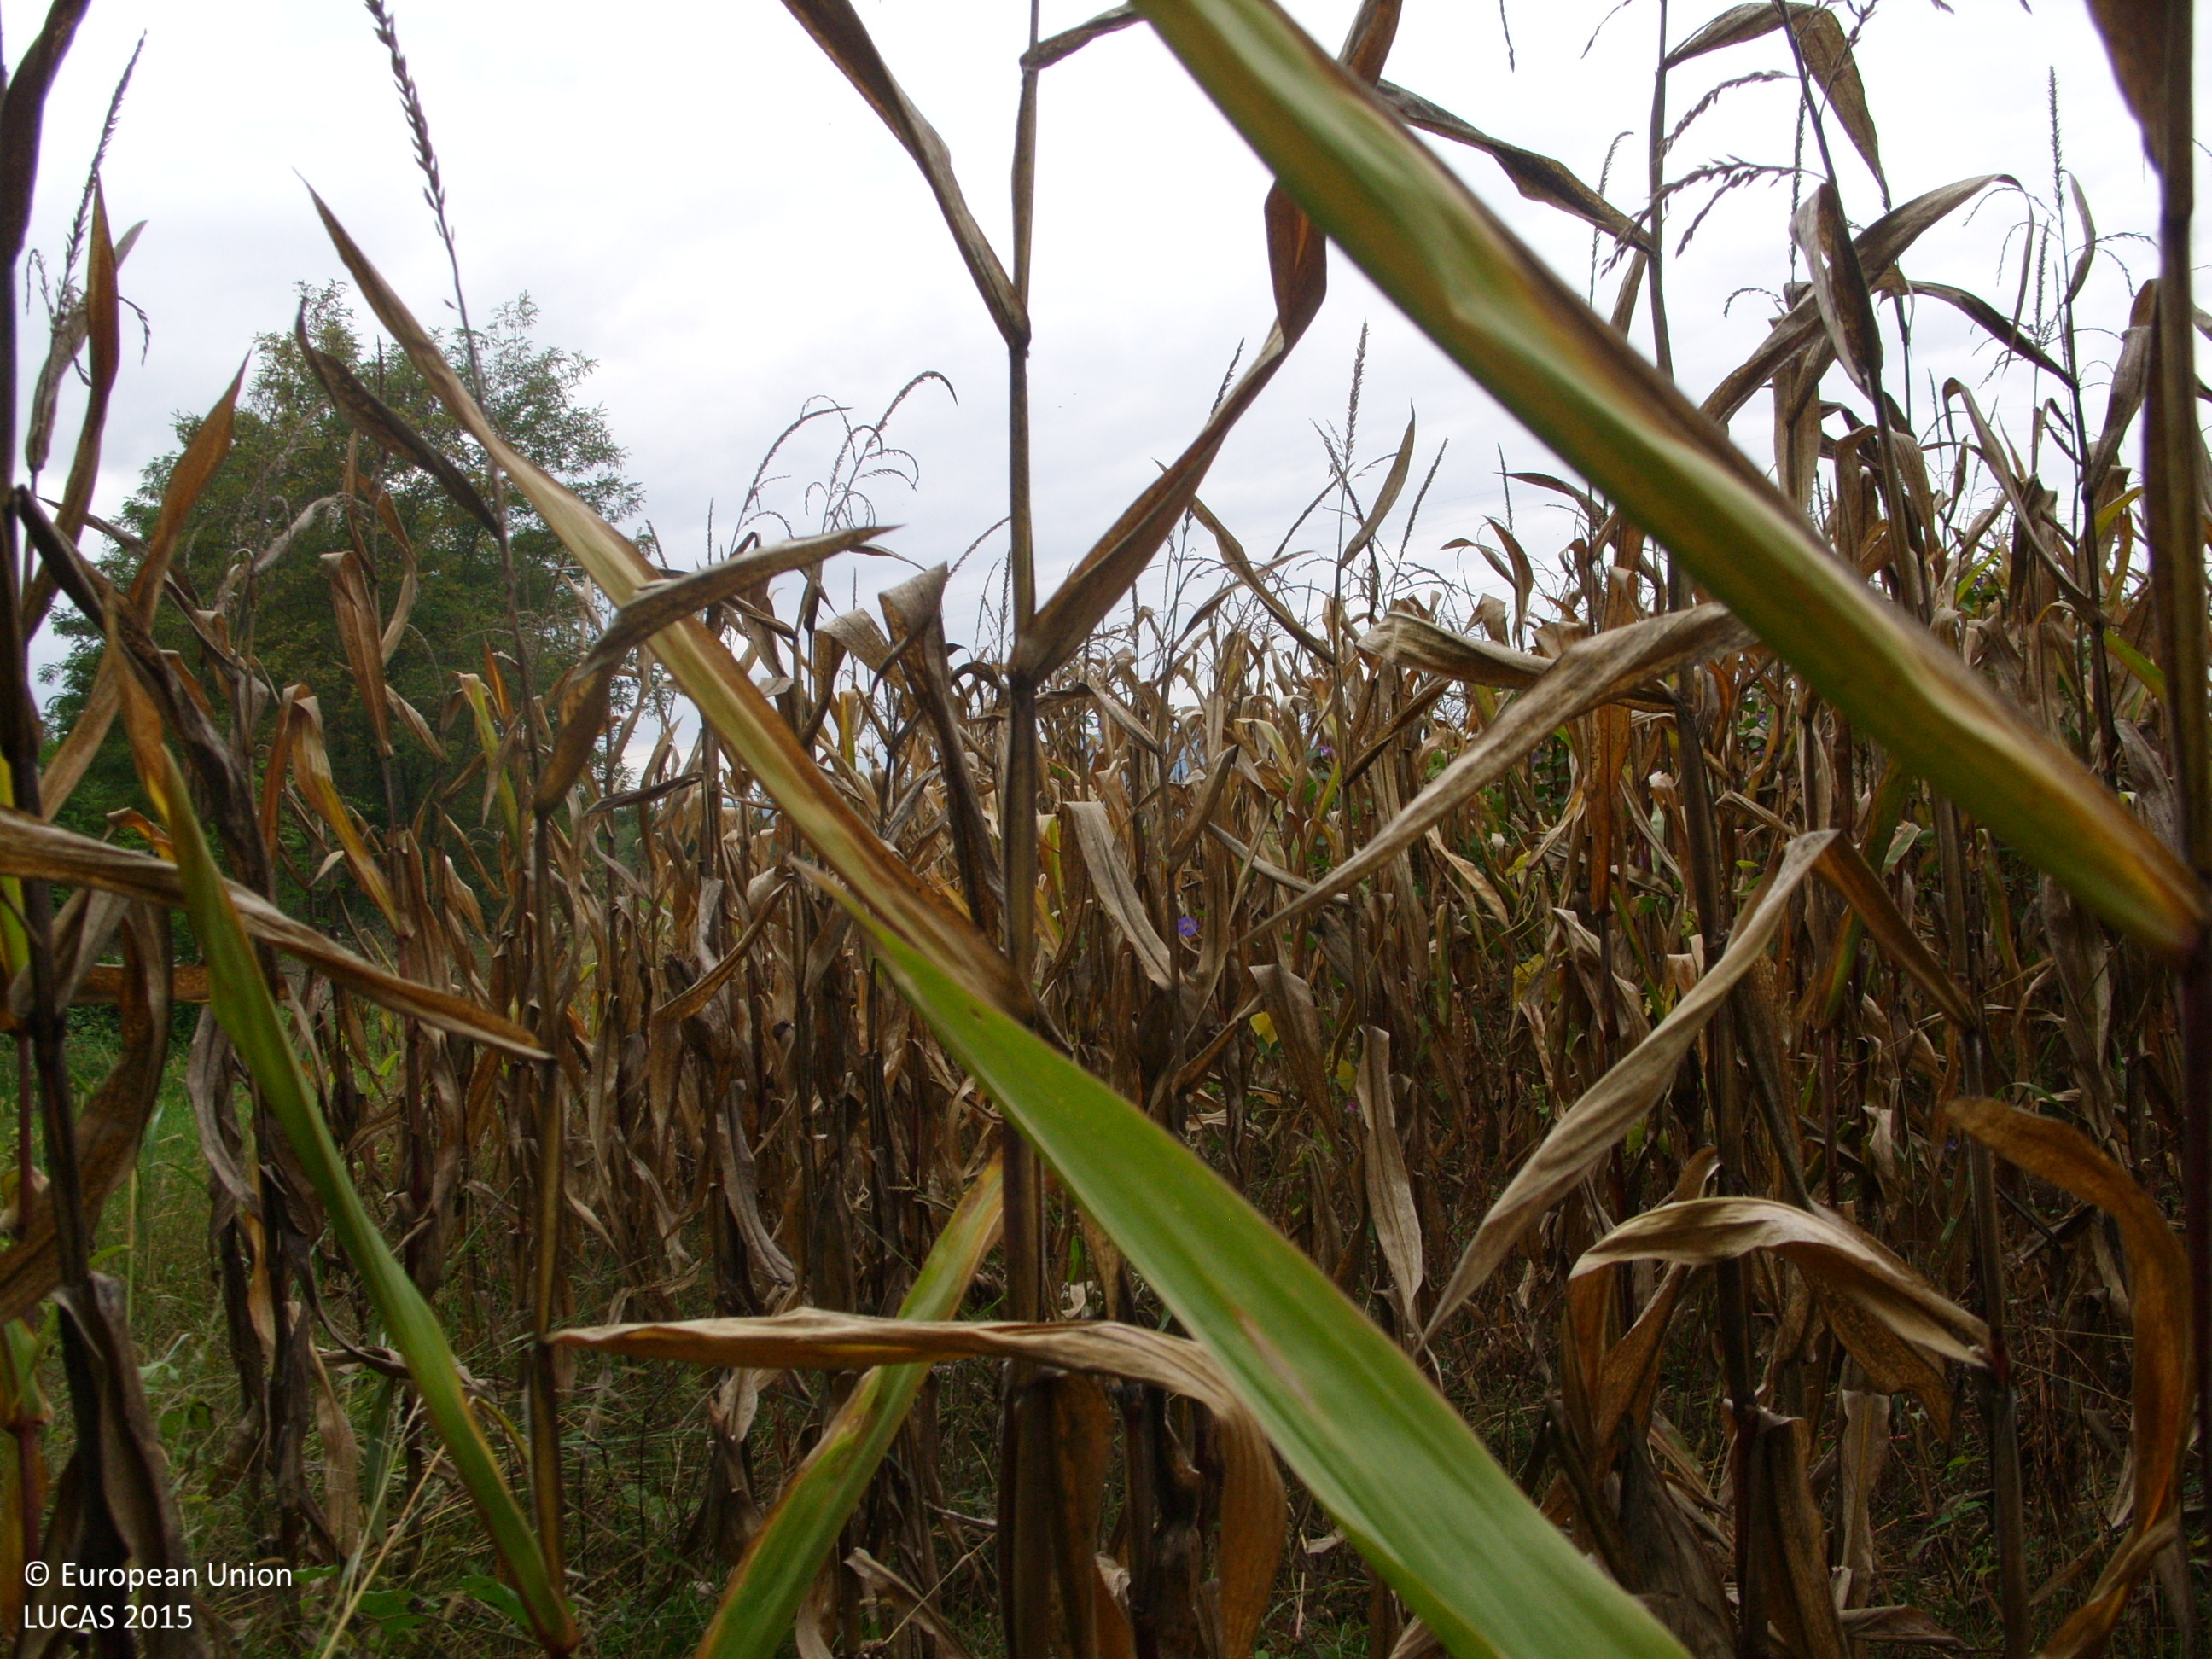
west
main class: Cropland
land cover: Maize
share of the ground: > 75 %
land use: Agriculture (excluding fallow land and kitchen gardens)
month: October
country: BG
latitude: 42.5206
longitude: 24.8720
